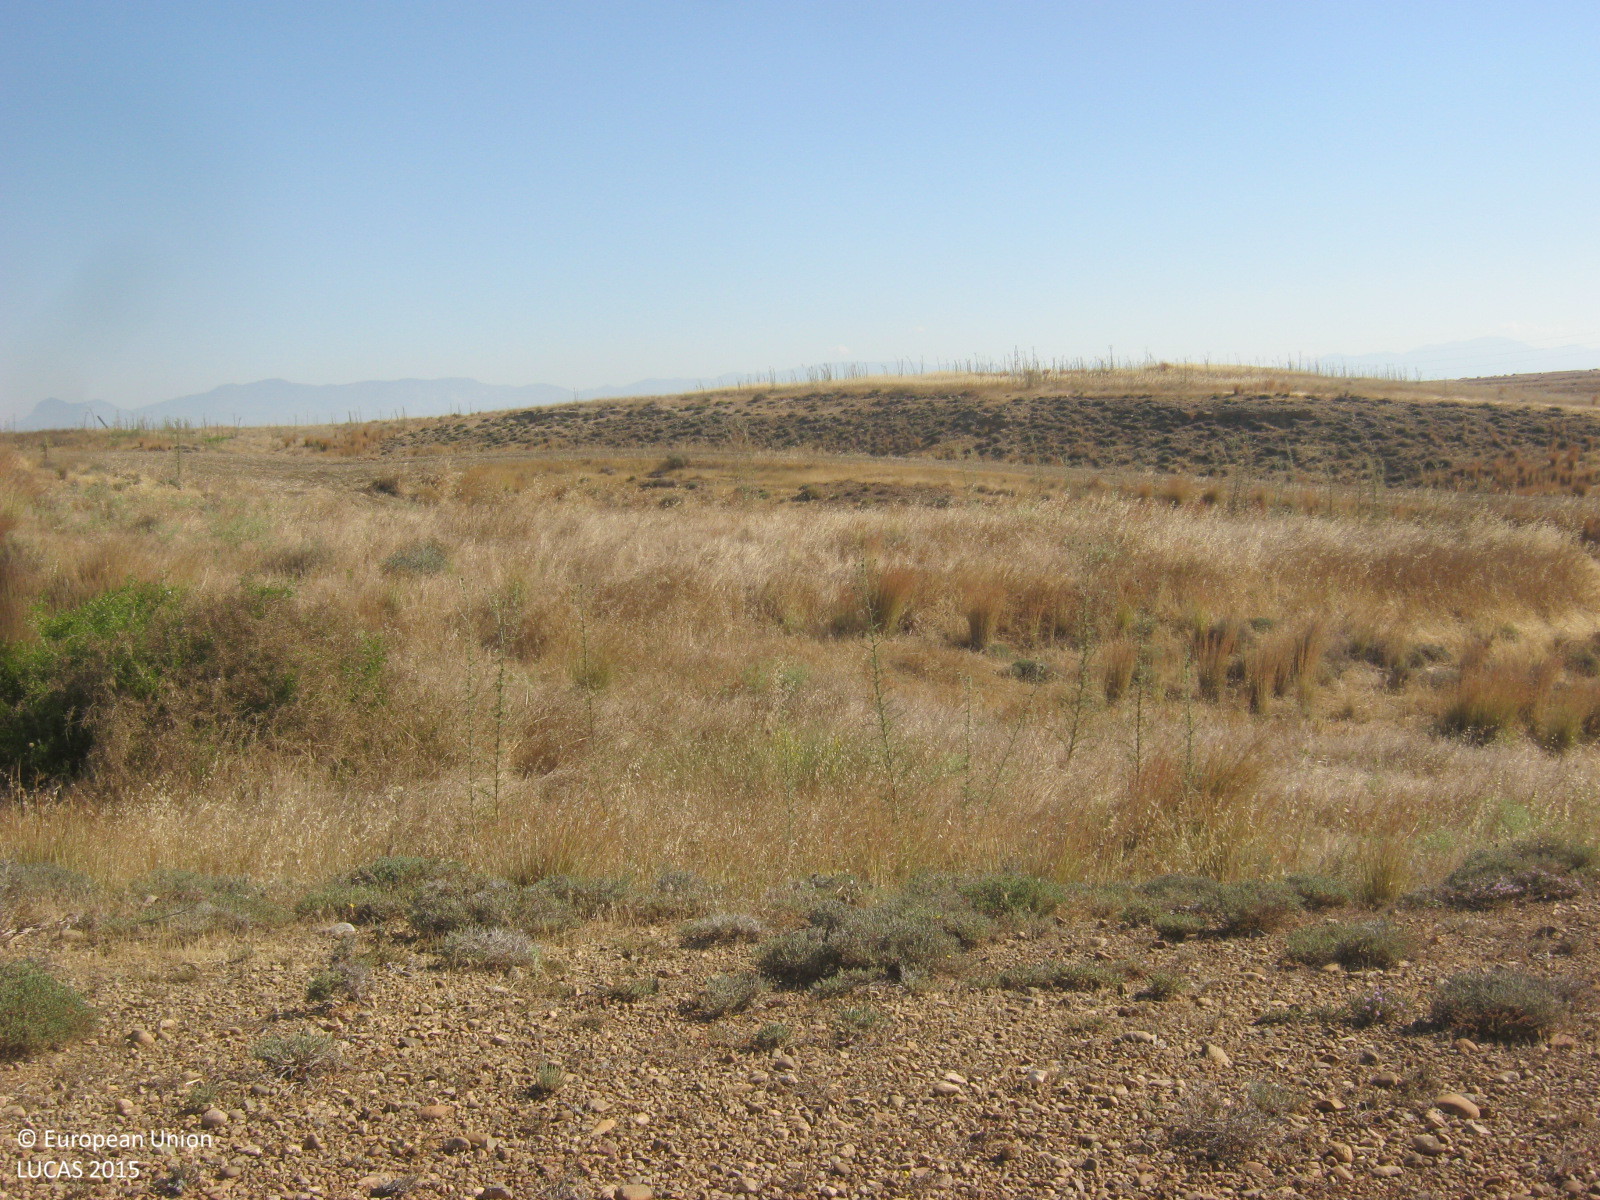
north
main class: Shrubland
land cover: Shrubland without tree cover
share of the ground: 10 - 25 %
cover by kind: herbaceous plants 70 %, shrubs 15 %, unconsolidated bare surface 15 %
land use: Semi-natural and natural areas not in use
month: June
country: CY
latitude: 35.1071
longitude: 33.1685
